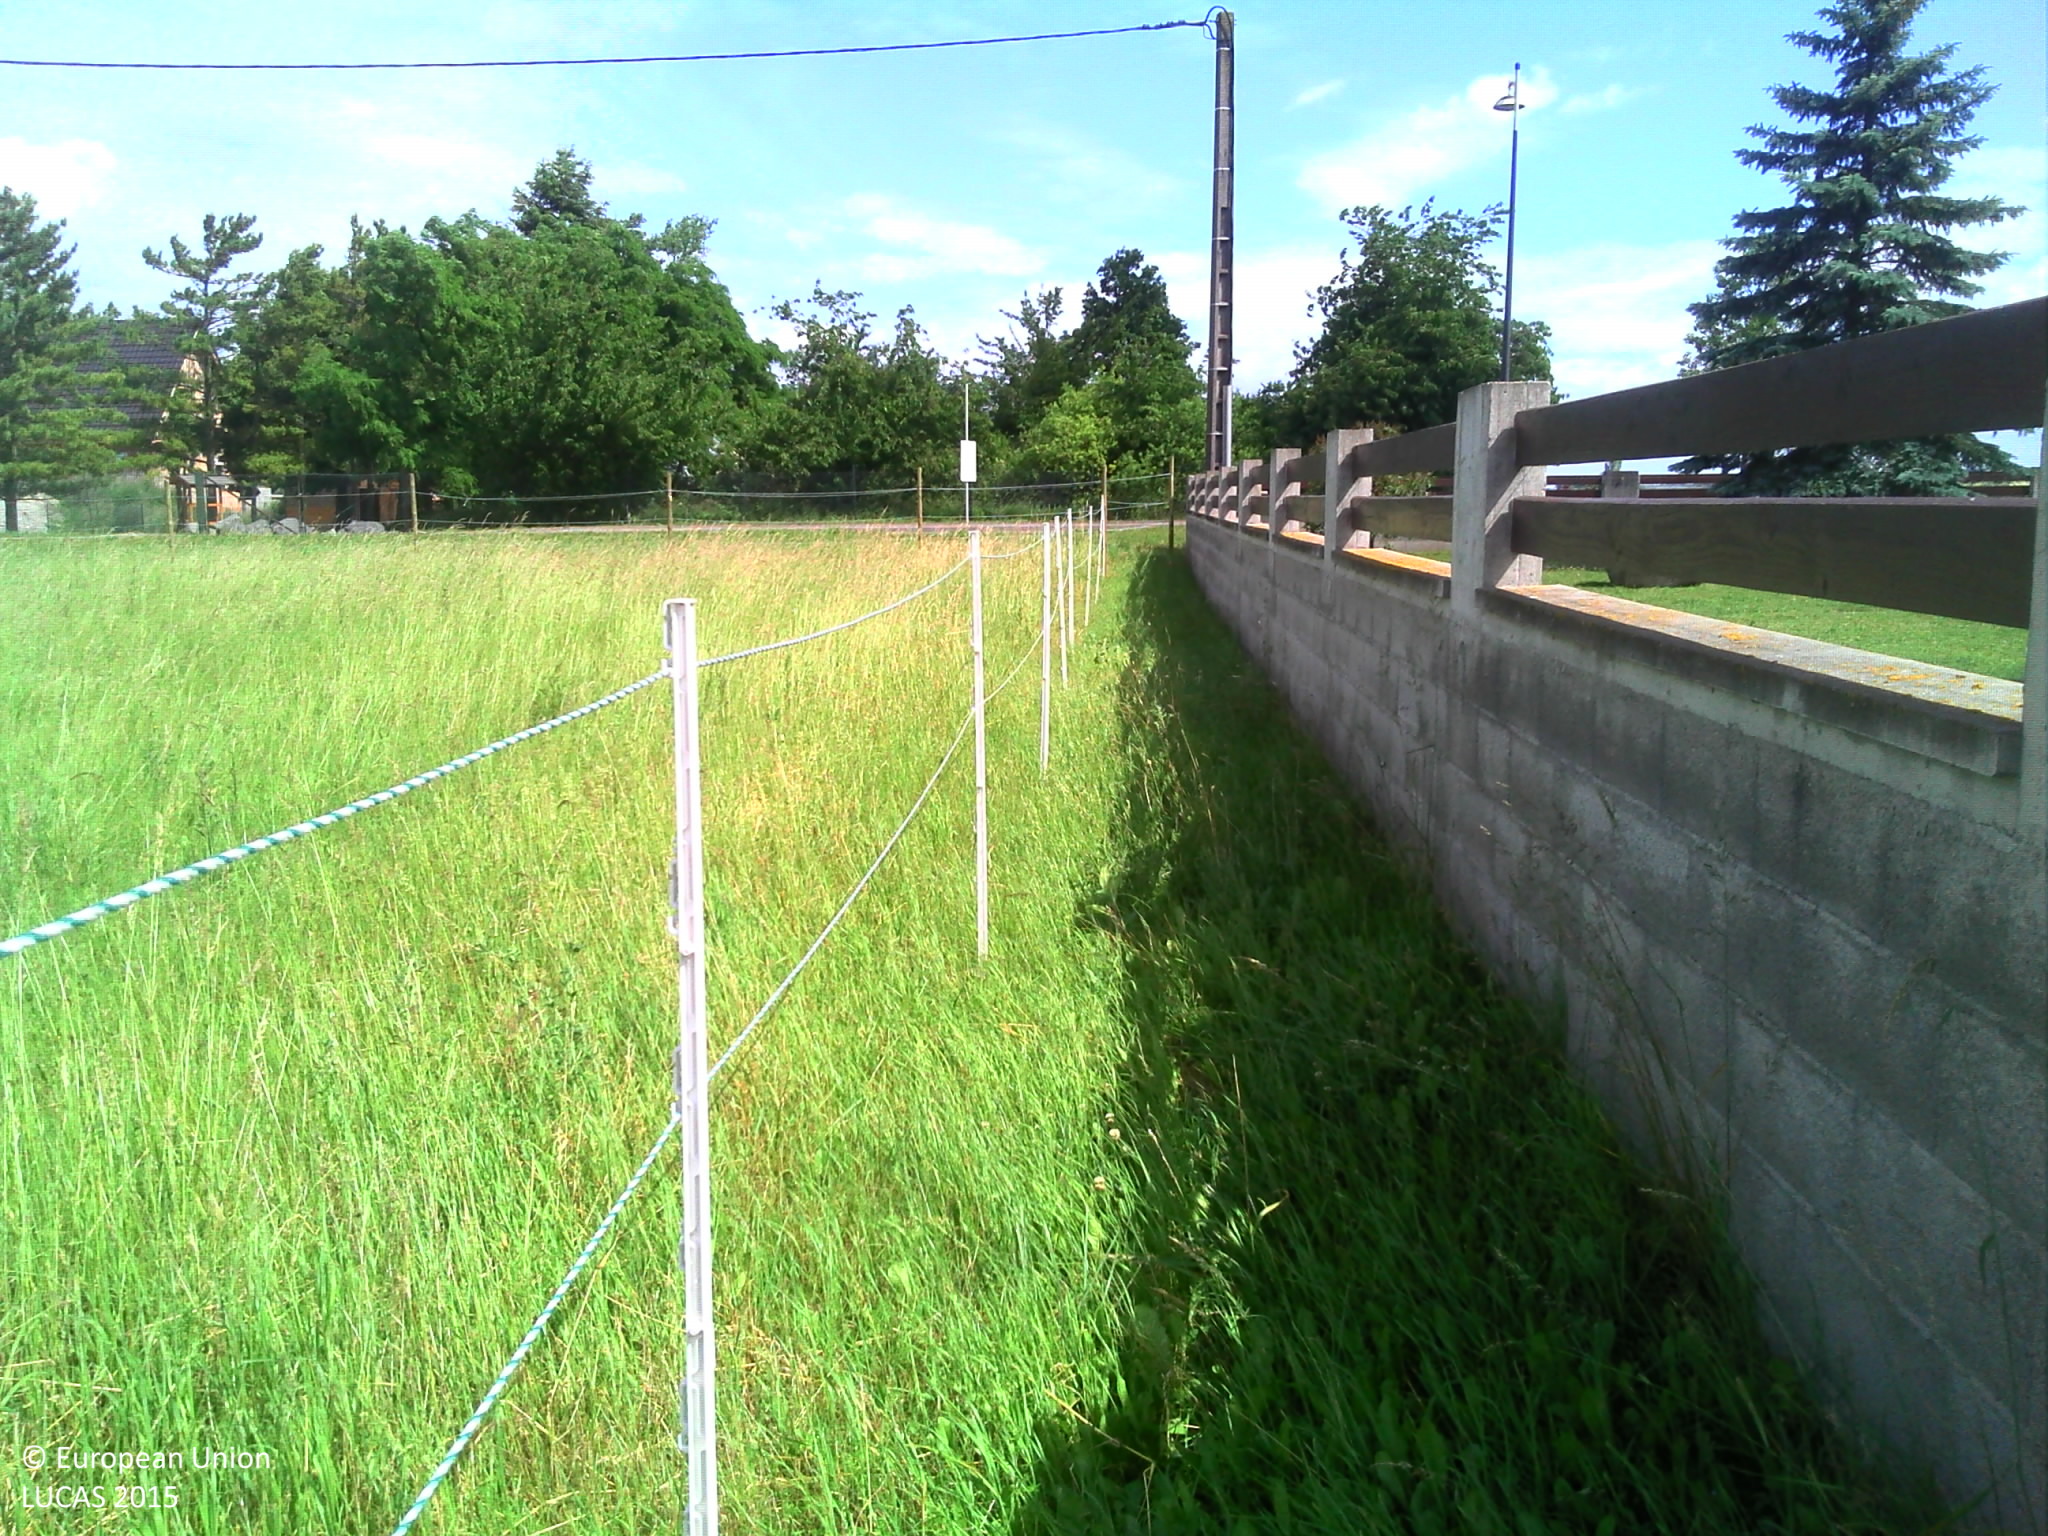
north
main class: Grassland
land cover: Grassland without tree/shrub cover
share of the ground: > 75 %
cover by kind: herbaceous plants 100 %
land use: Agriculture (excluding fallow land and kitchen gardens)
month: June
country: FR
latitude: 47.8885
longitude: 7.4737
